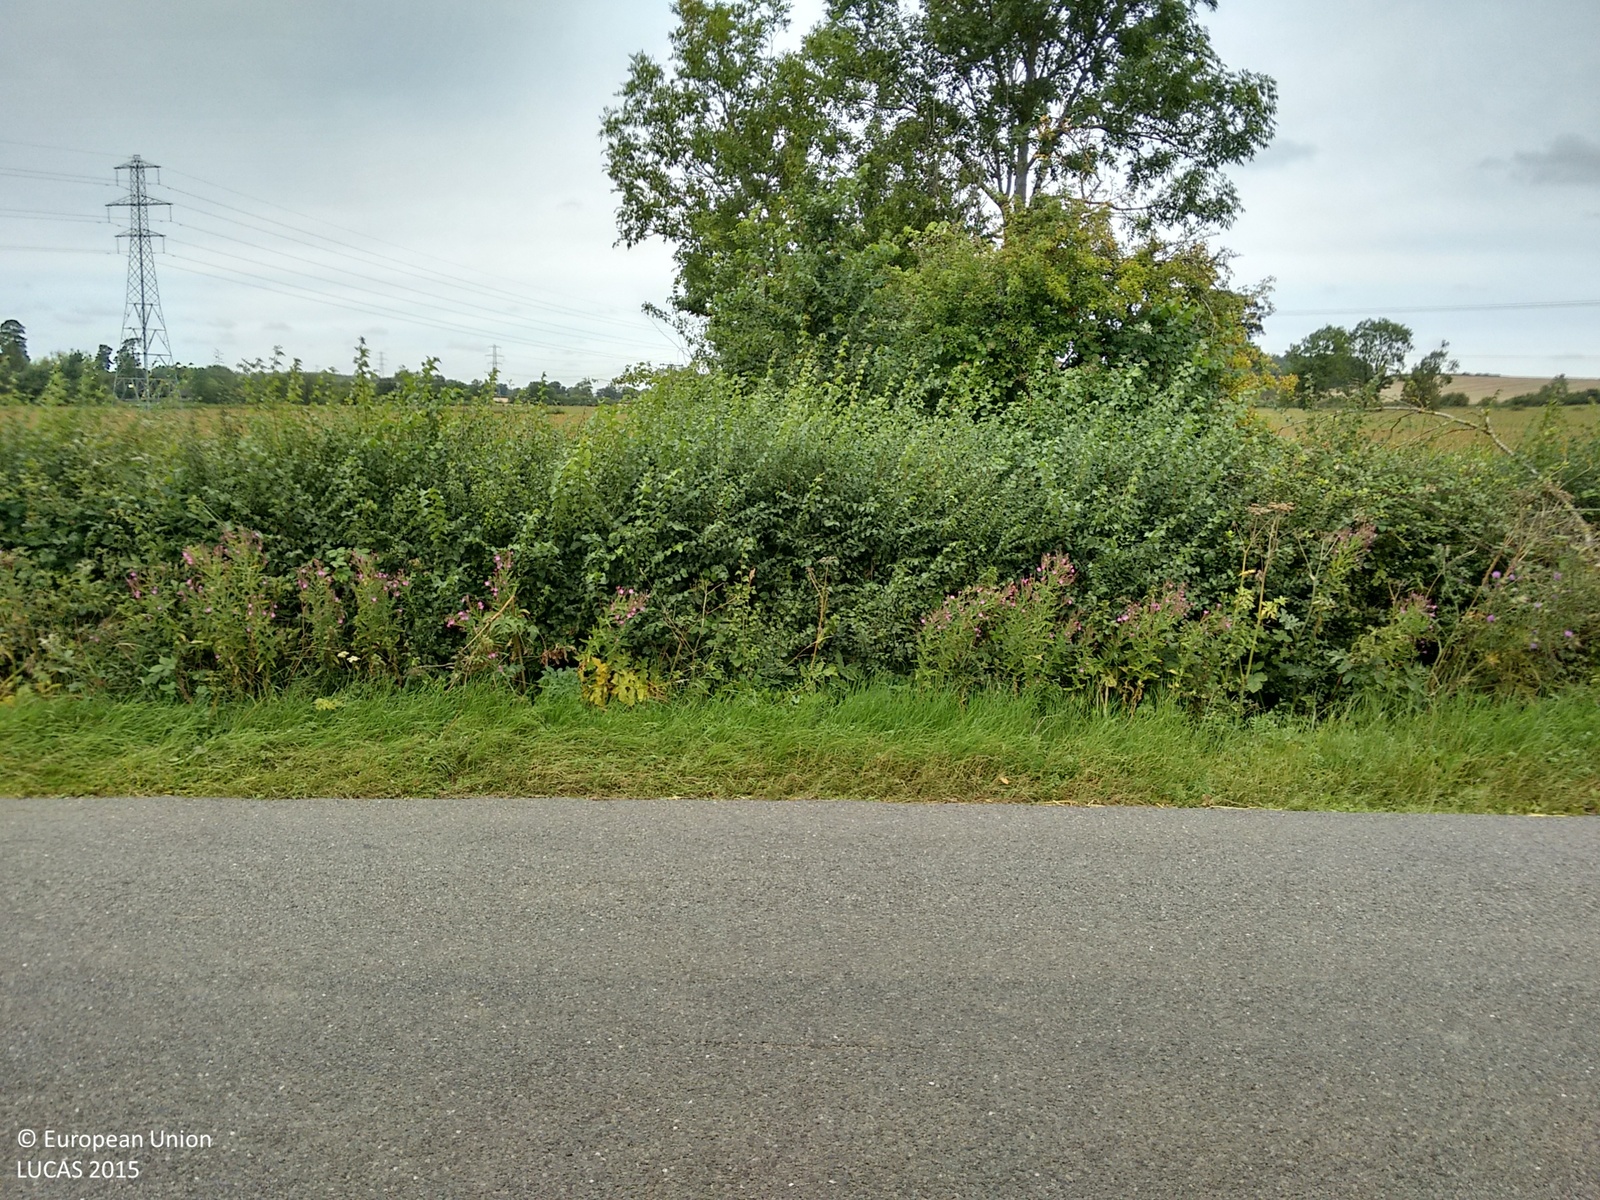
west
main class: Cropland
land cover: Maize
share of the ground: > 75 %
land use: Agriculture (excluding fallow land and kitchen gardens)
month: August
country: GB
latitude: 52.0806
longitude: -1.2101
